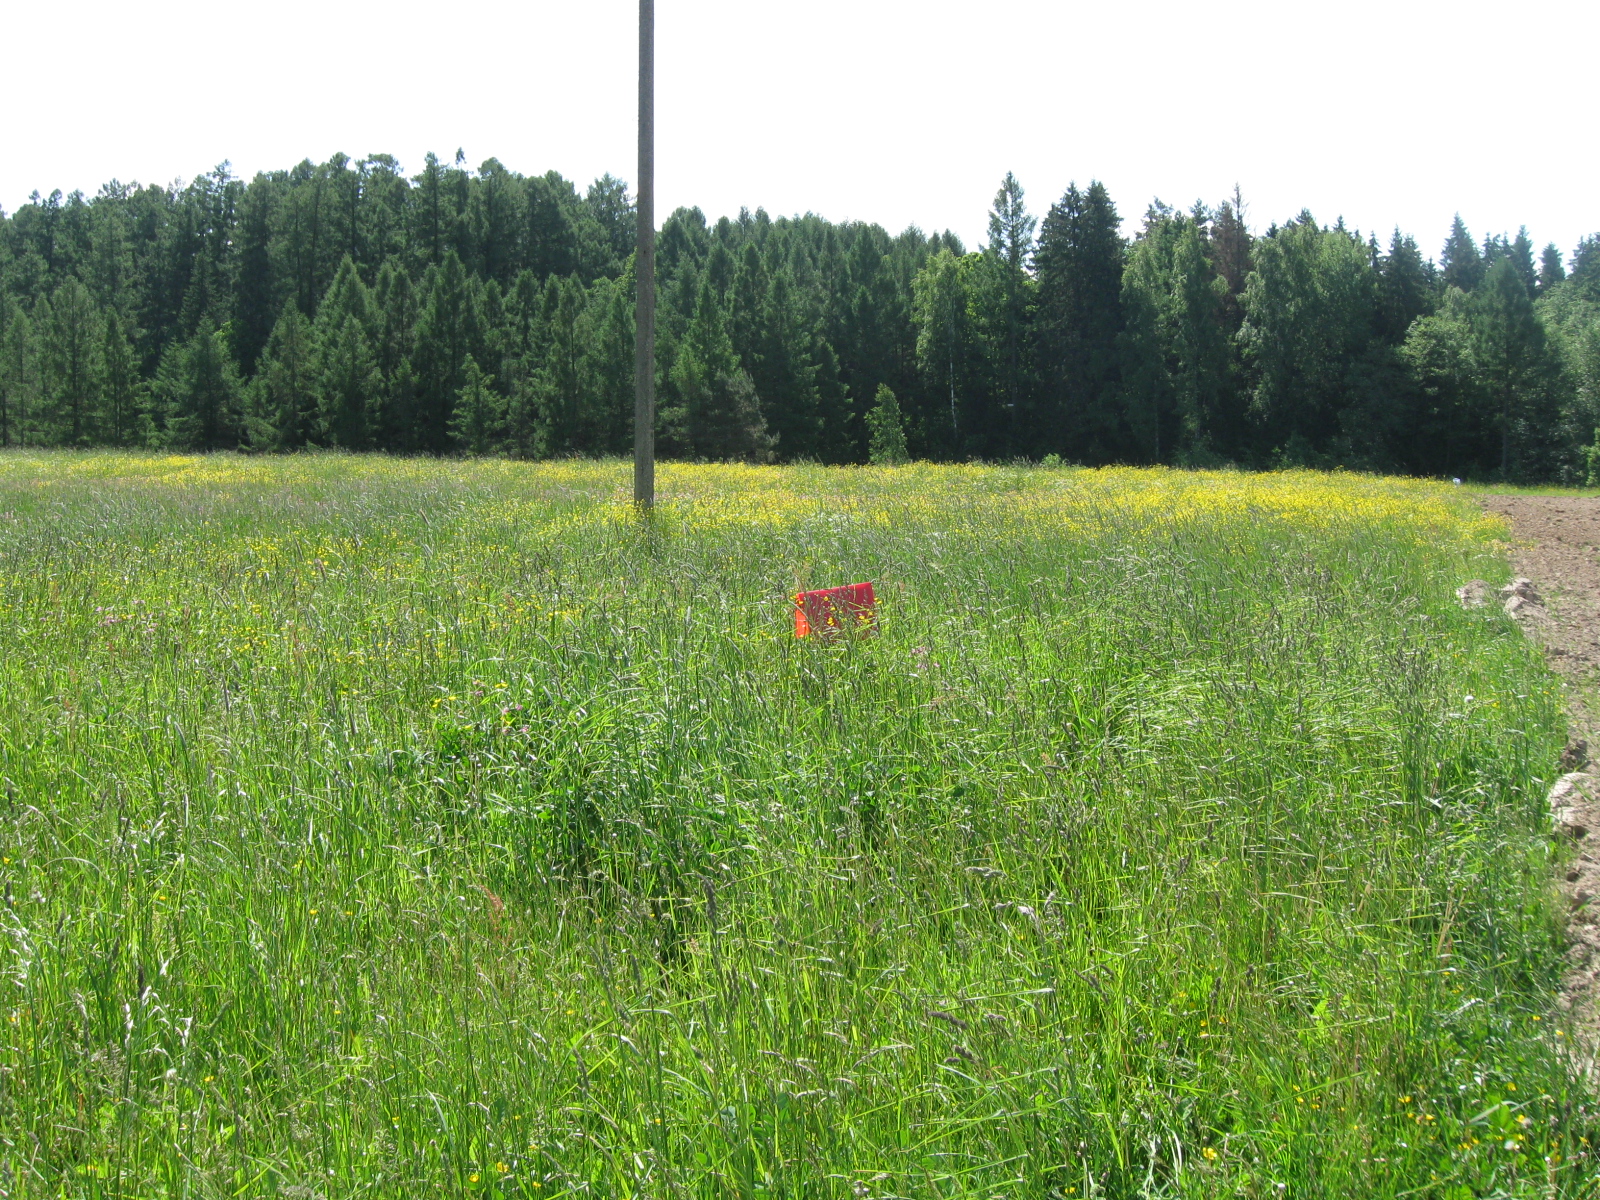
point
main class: Grassland
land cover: Grassland without tree/shrub cover
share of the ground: > 75 %
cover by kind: herbaceous plants 100 %
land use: Agriculture (excluding fallow land and kitchen gardens)
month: June
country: LT
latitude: 54.5706
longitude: 23.8713
